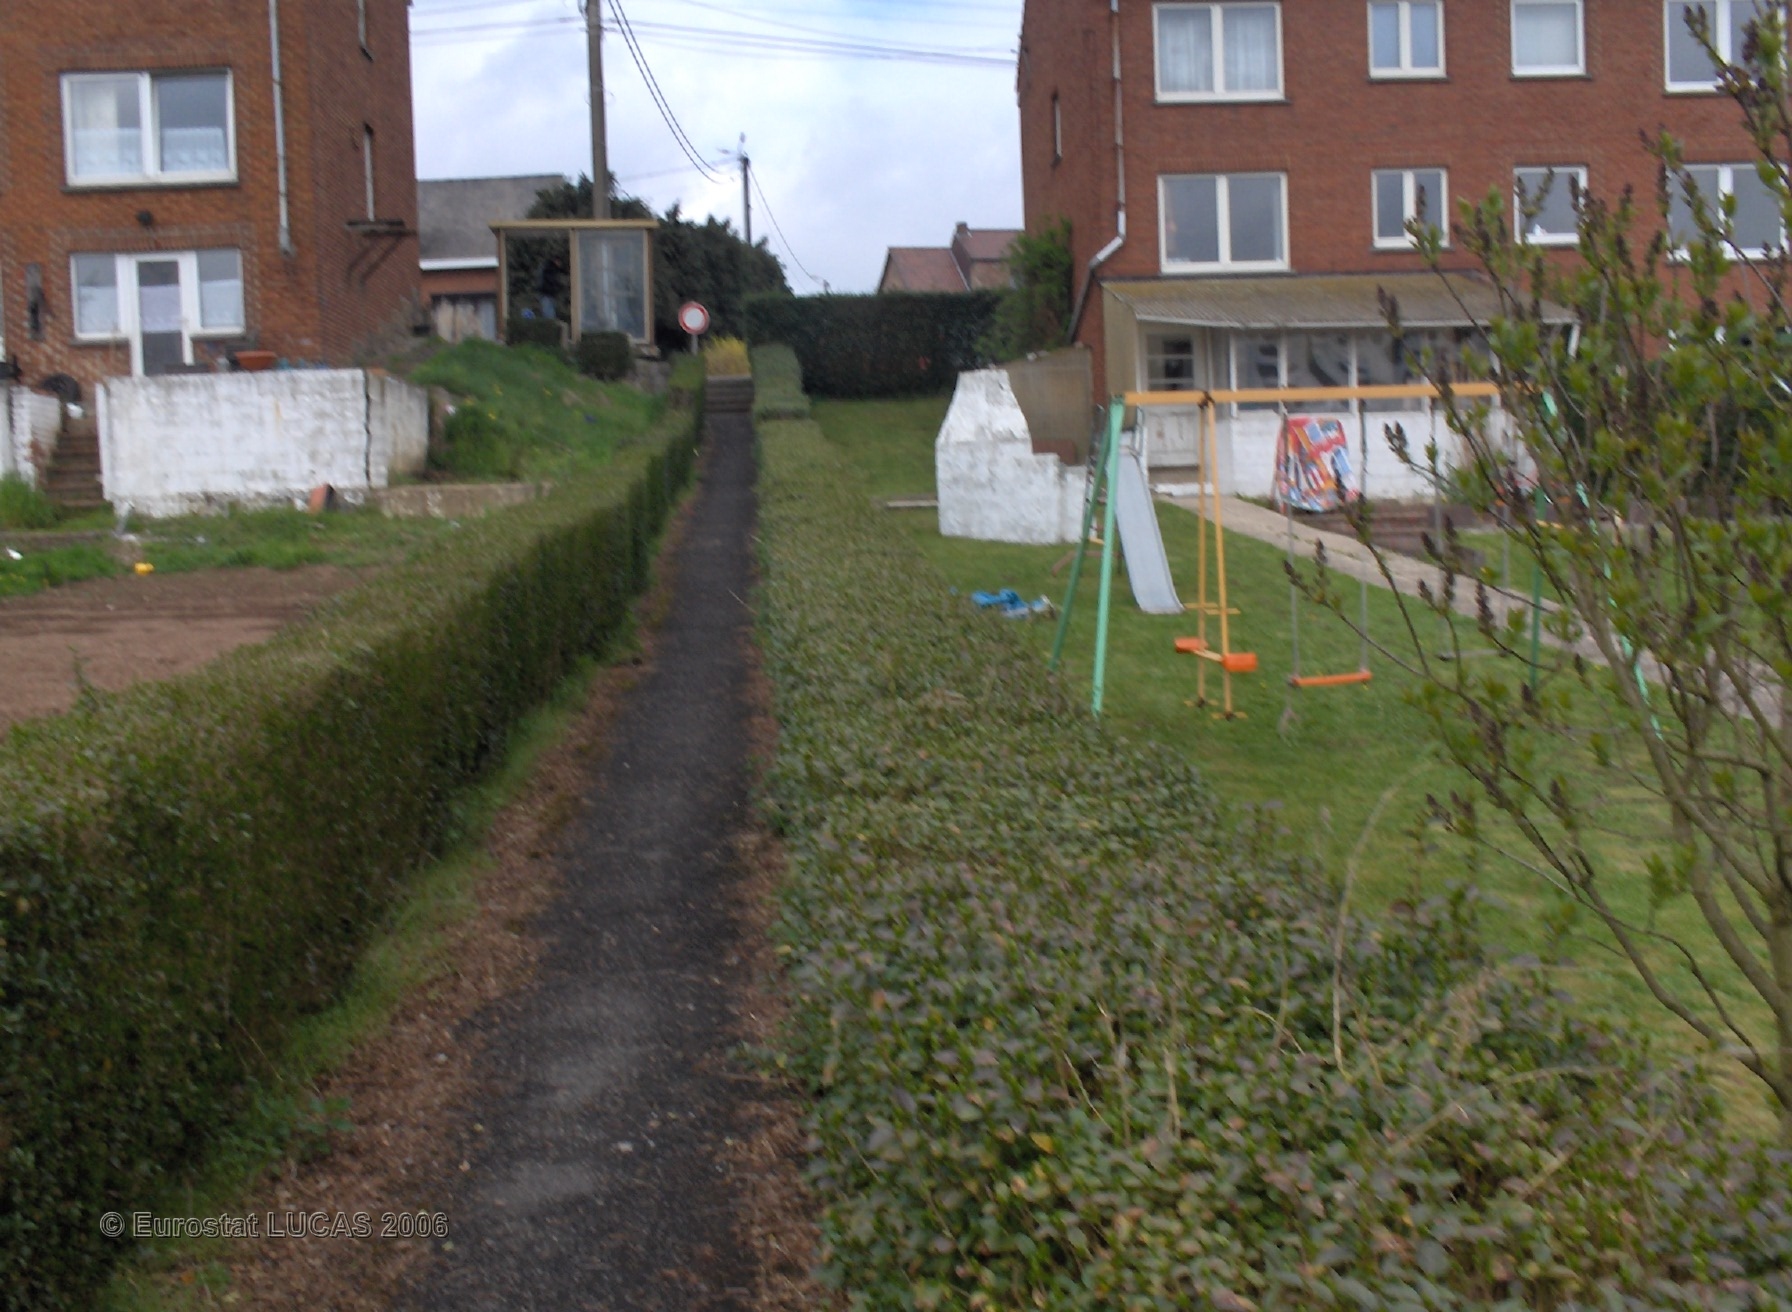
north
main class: Grassland
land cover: Grassland with sparse tree/shrub cover
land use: Residential
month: April
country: BE
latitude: 50.3593
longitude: 4.5280
